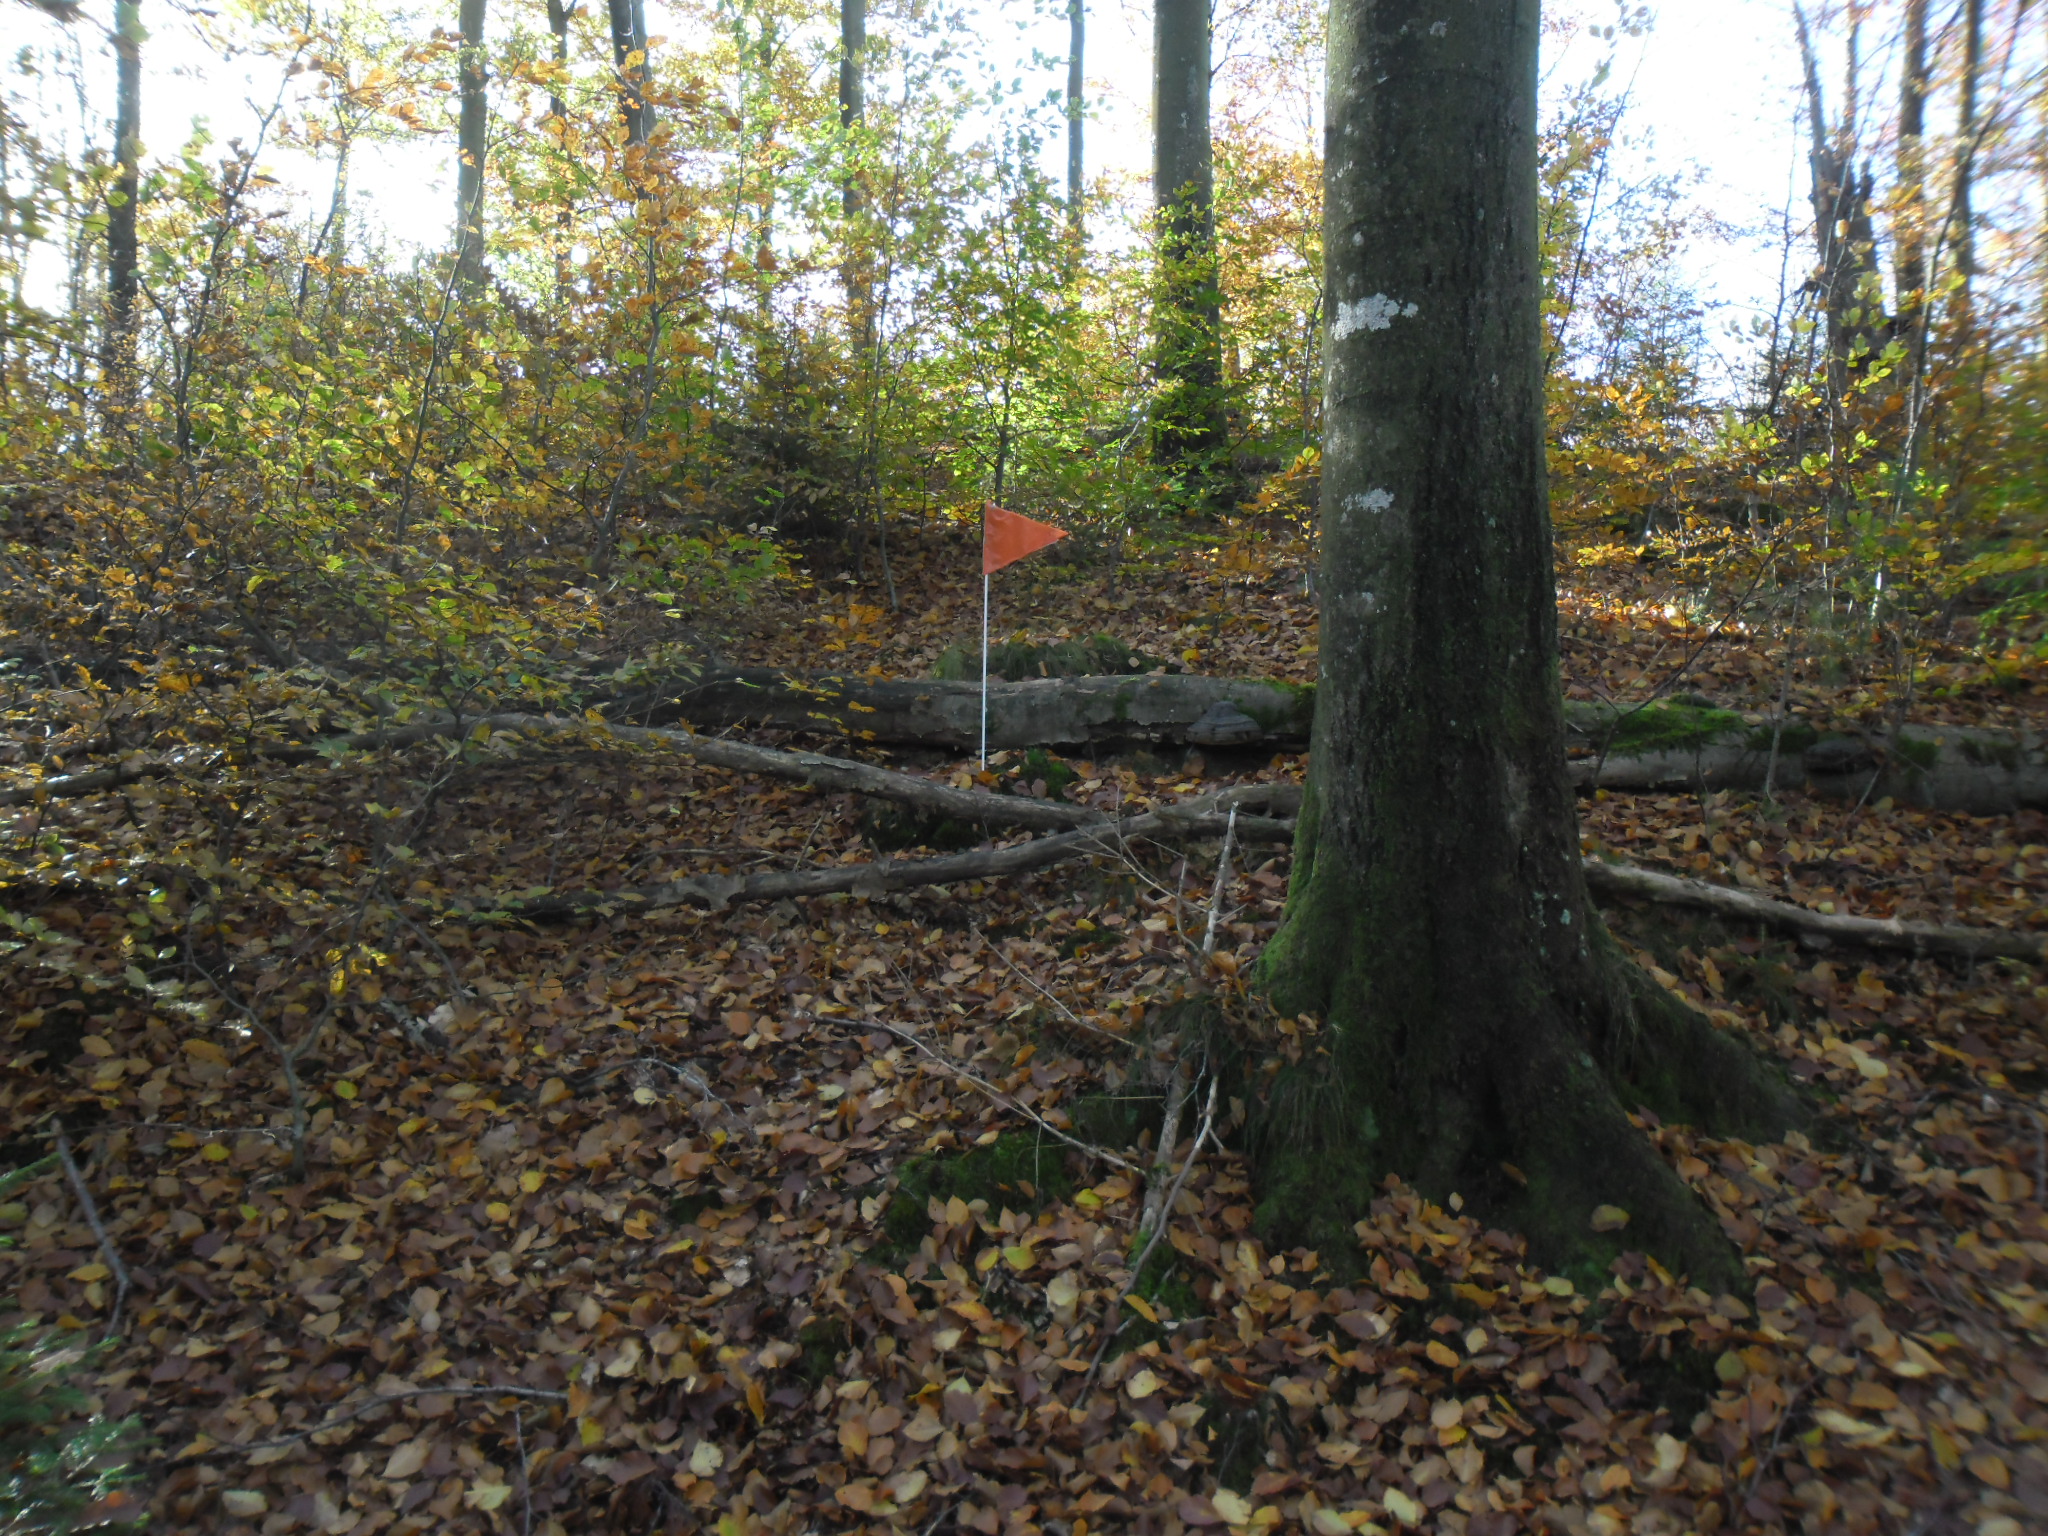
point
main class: Woodland
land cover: Broadleaved woodland
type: beech forest
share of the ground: > 75 %
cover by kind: broadleaved forest trees 80 %, herbaceous plants 20 %
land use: Forestry
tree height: > 5 m
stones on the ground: > 50 %
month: October
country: SE
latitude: 56.3665
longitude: 13.0892
